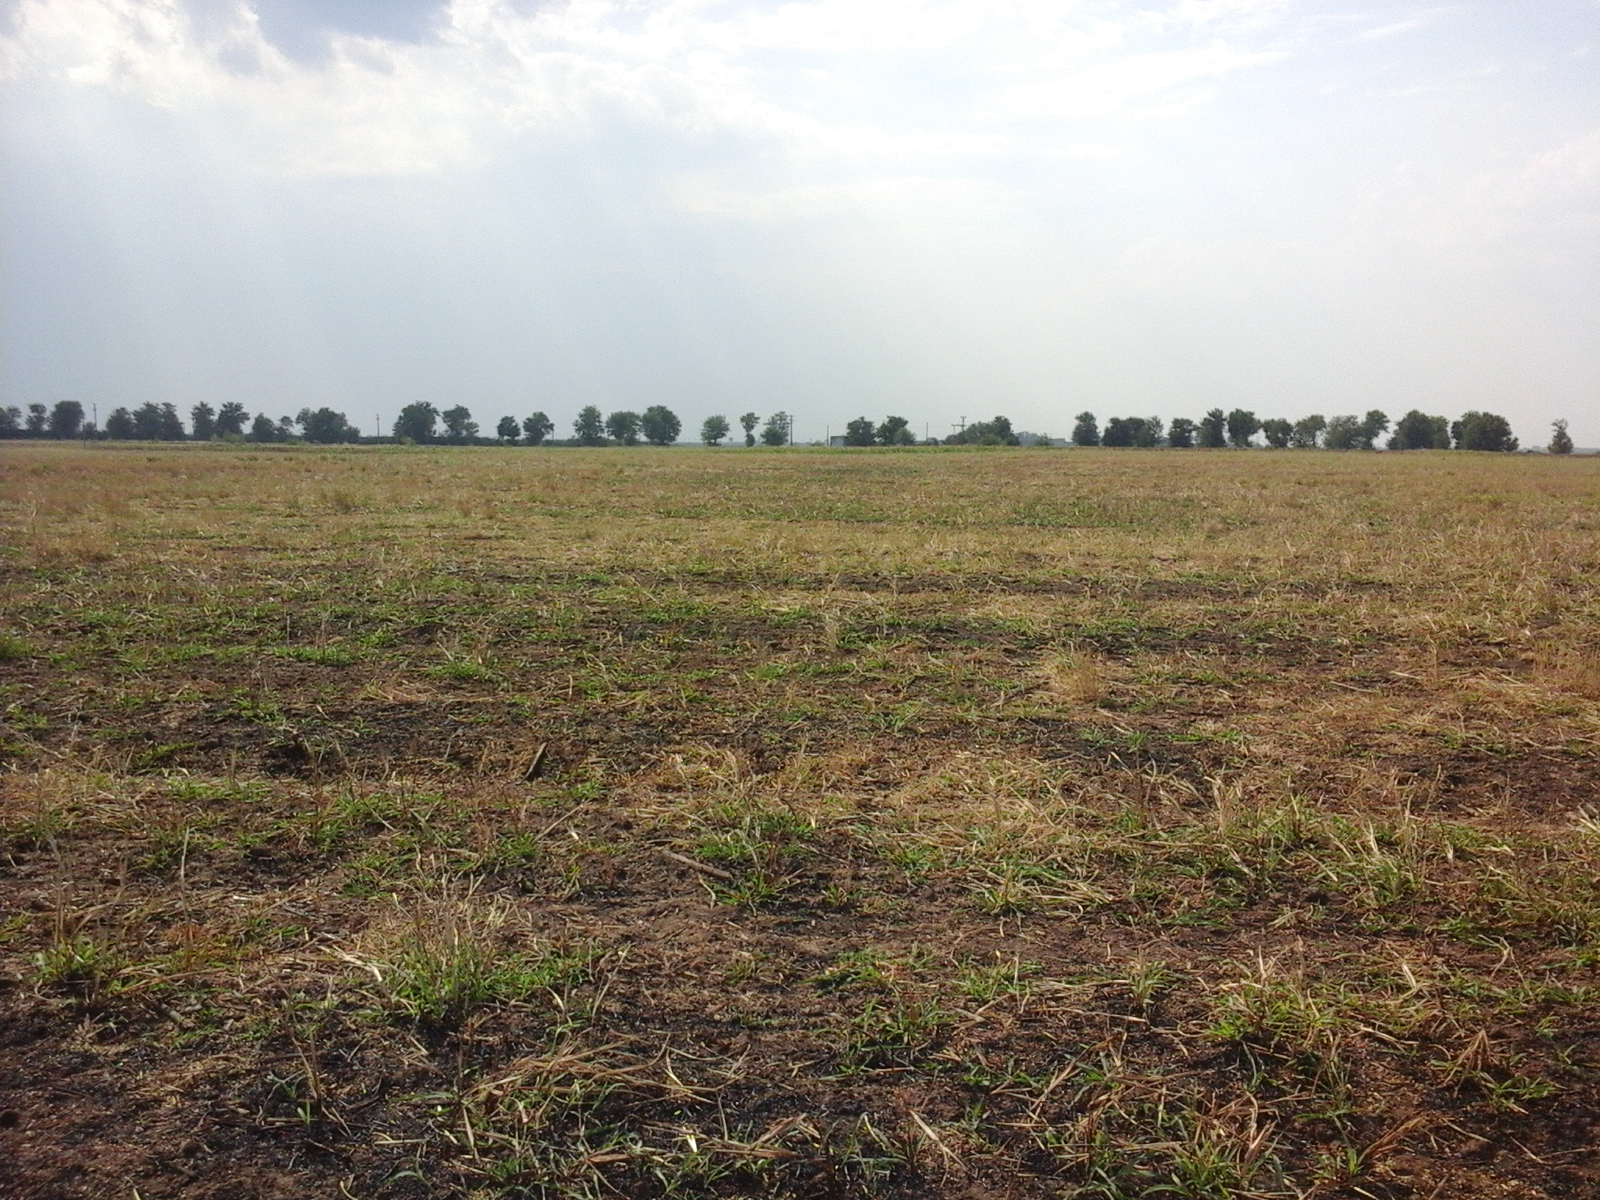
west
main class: Cropland
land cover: Common wheat
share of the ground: 50 - 75 %
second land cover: Spontaneously vegetated surfaces
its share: > 75 %
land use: Agriculture (excluding fallow land and kitchen gardens)
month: August
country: RO
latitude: 43.9850
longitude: 23.4257
